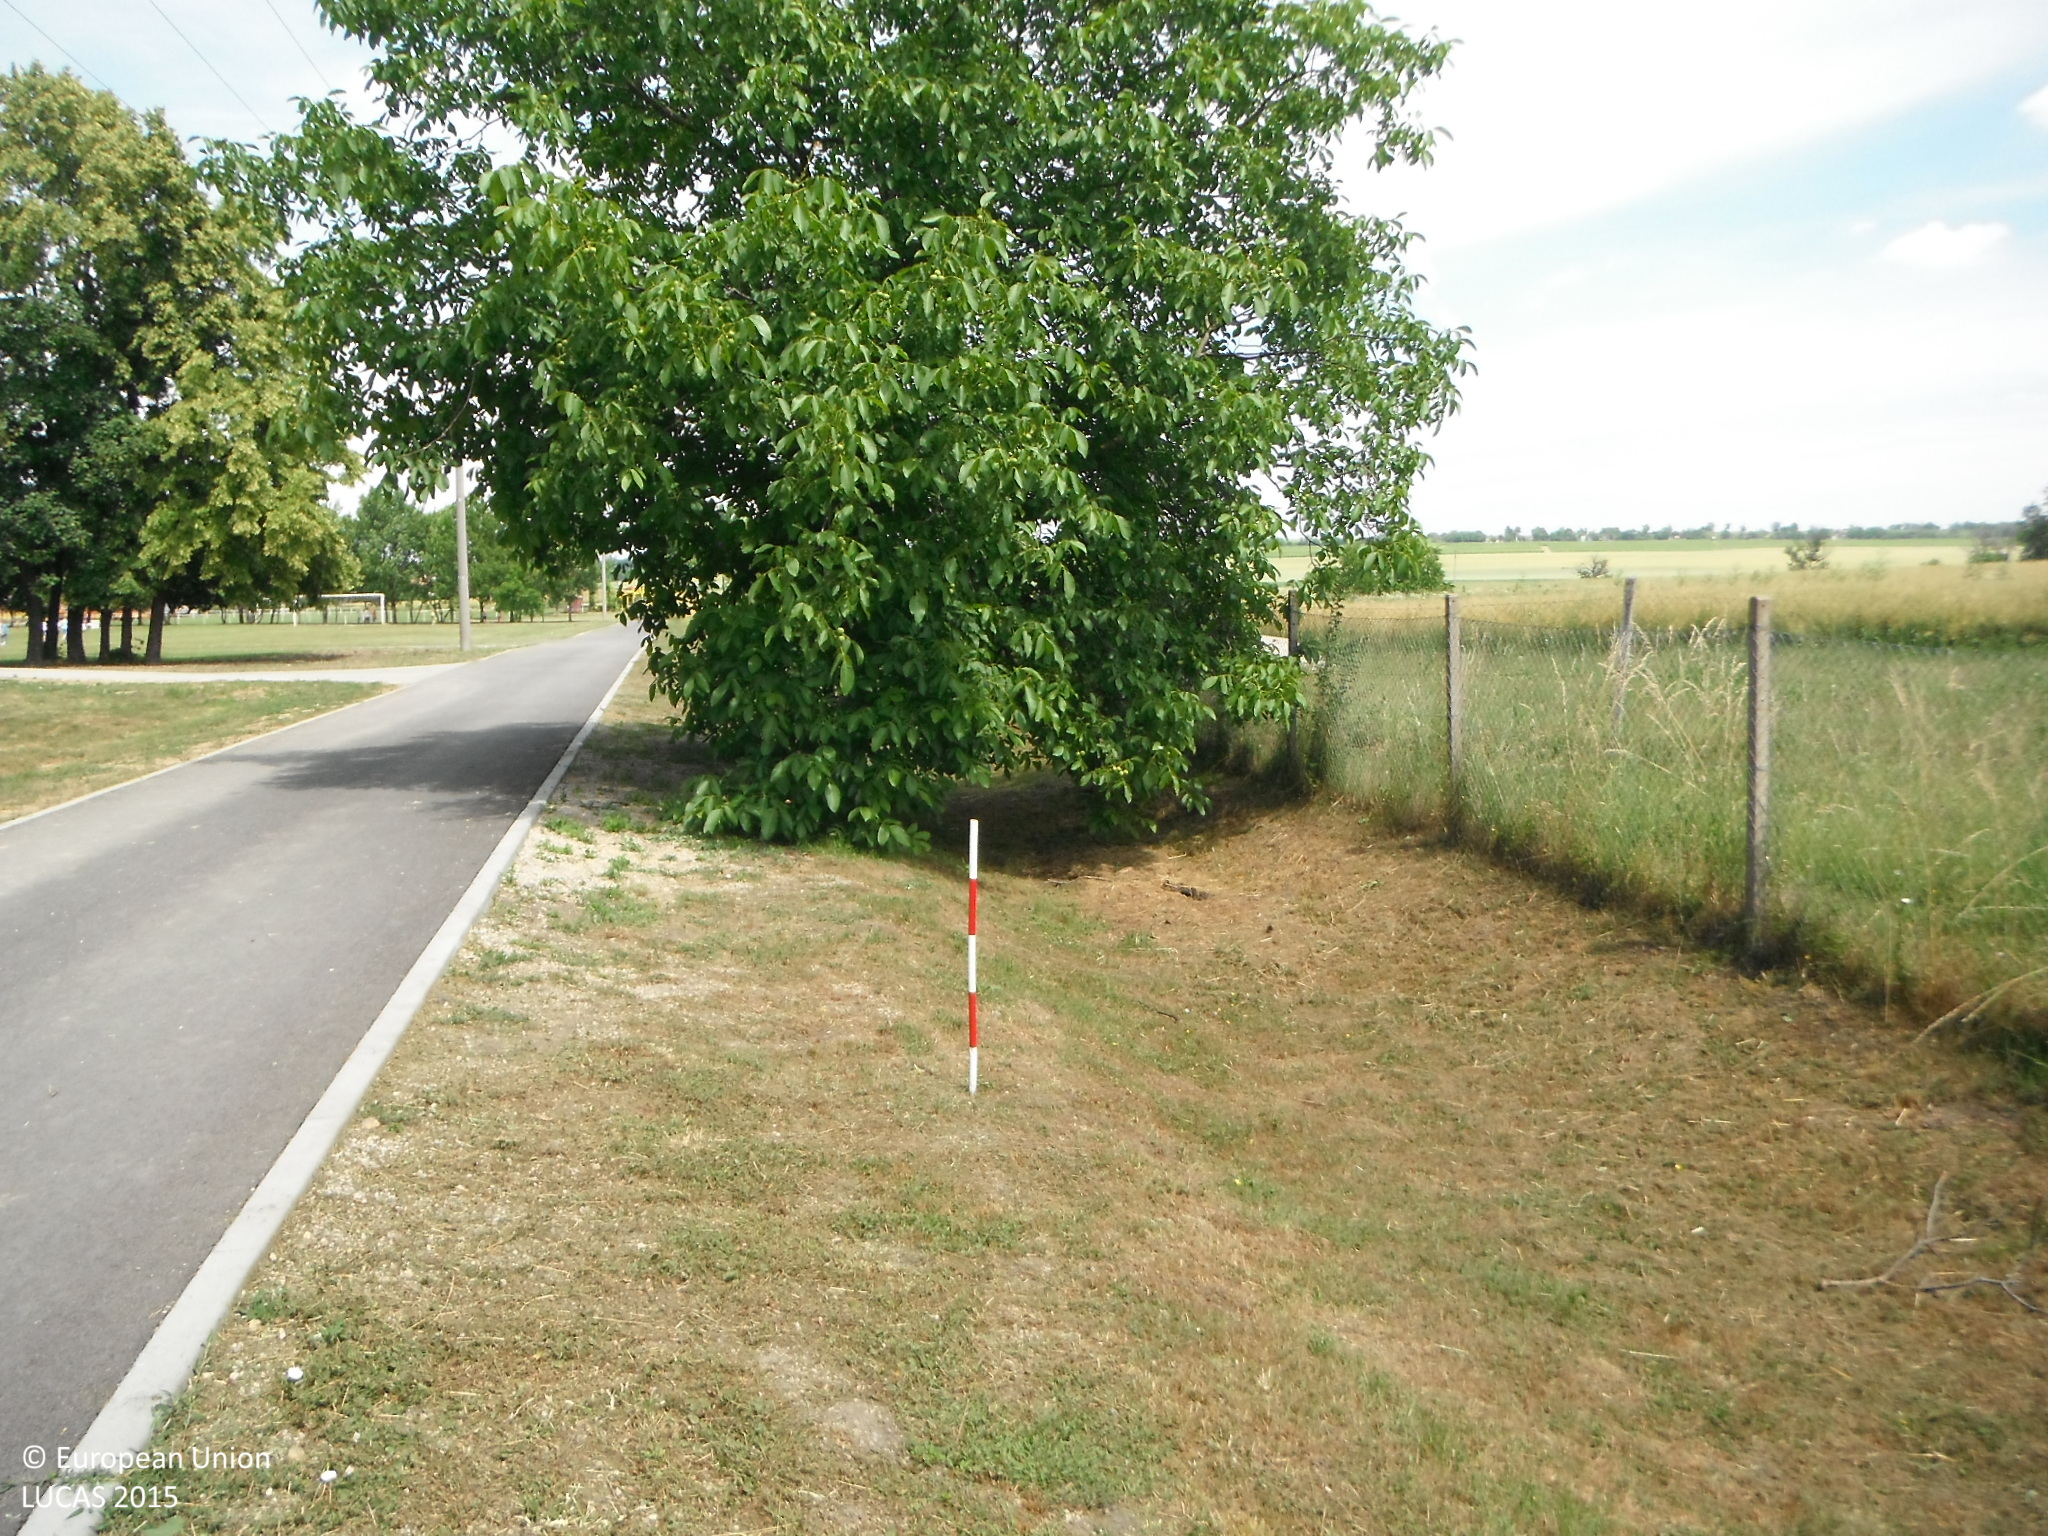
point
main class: Grassland
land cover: Grassland without tree/shrub cover
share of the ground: > 75 %
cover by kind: herbaceous plants 100 %
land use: Community services
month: June
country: SK
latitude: 48.1885
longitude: 18.2061
